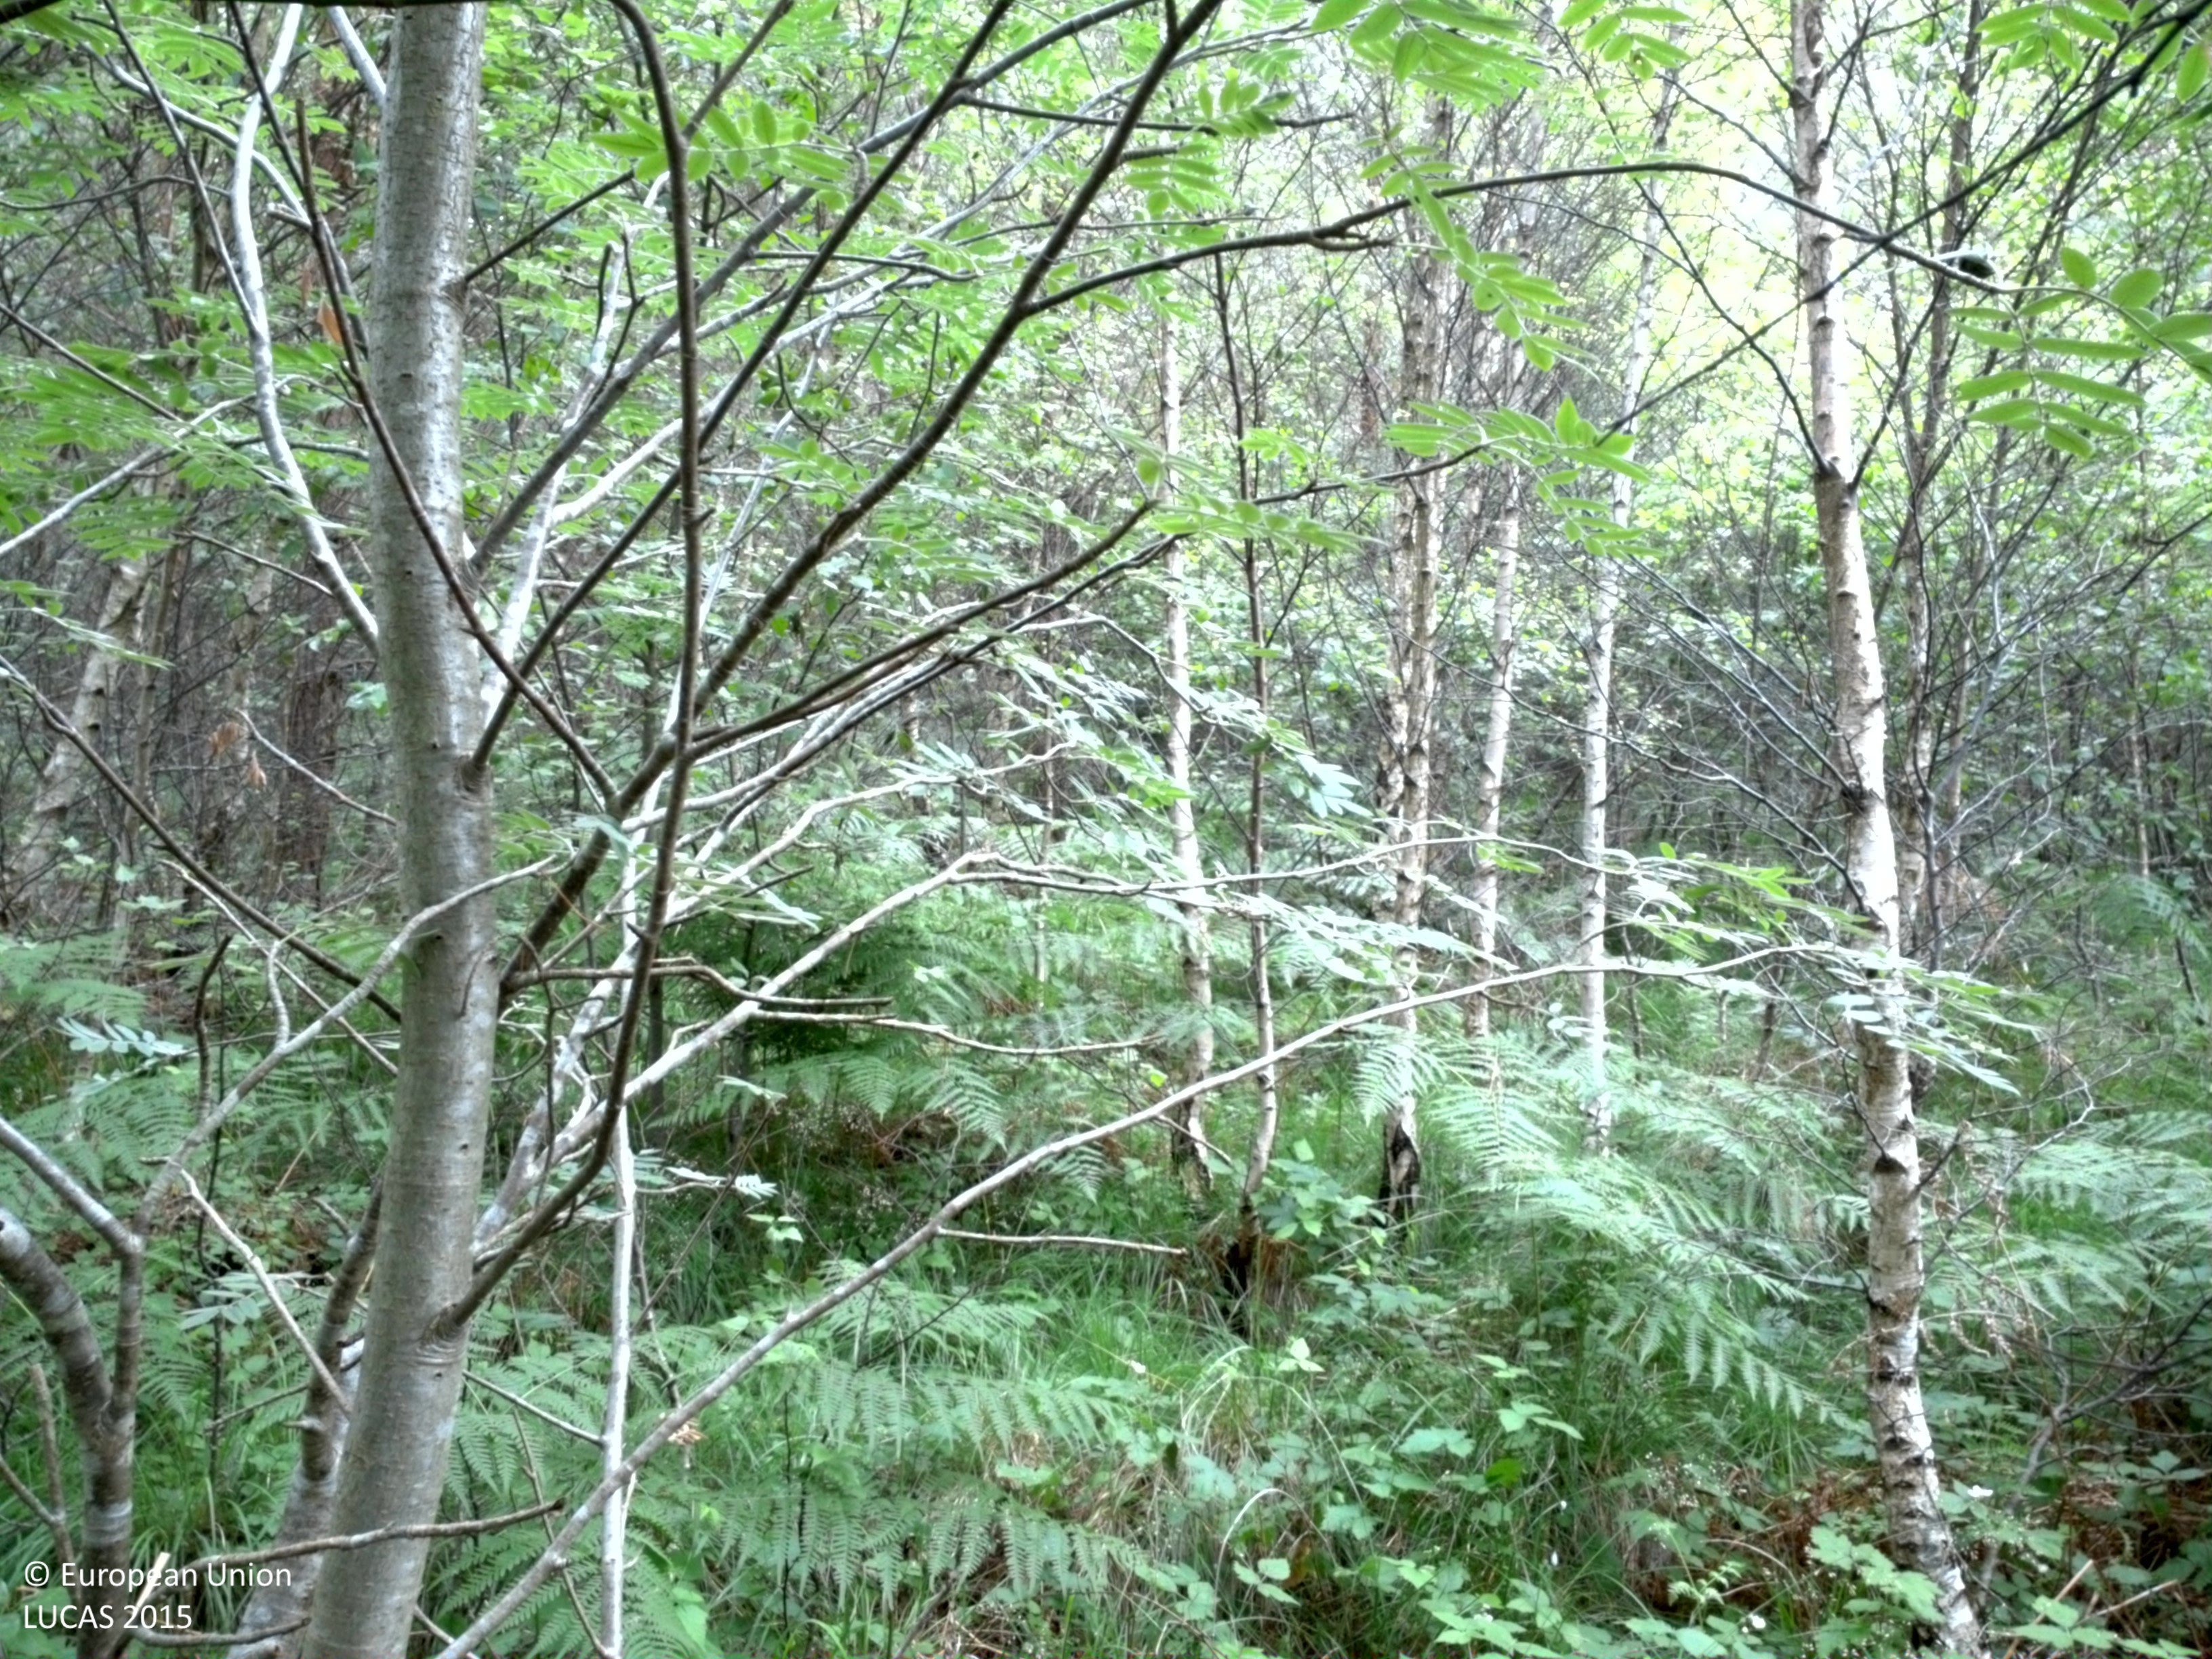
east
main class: Woodland
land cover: Pine dominated mixed woodland
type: hemiboreal forest and nemoral coniferous forest and mixed broadleaved-coniferous forest
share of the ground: > 75 %
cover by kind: coniferous forest trees 55 %, broadleaved forest trees 25 %, herbaceous plants 15 %, shrubs 5 %
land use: Forestry
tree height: > 5 m
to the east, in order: Pine dominated mixed woodland; Rivers and streams; Pine dominated mixed woodland; Spruce dominated coniferous woodland; Other mixed woodland; Spruce dominated coniferous woodland
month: July
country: SE
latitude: 57.2864
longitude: 18.1197
